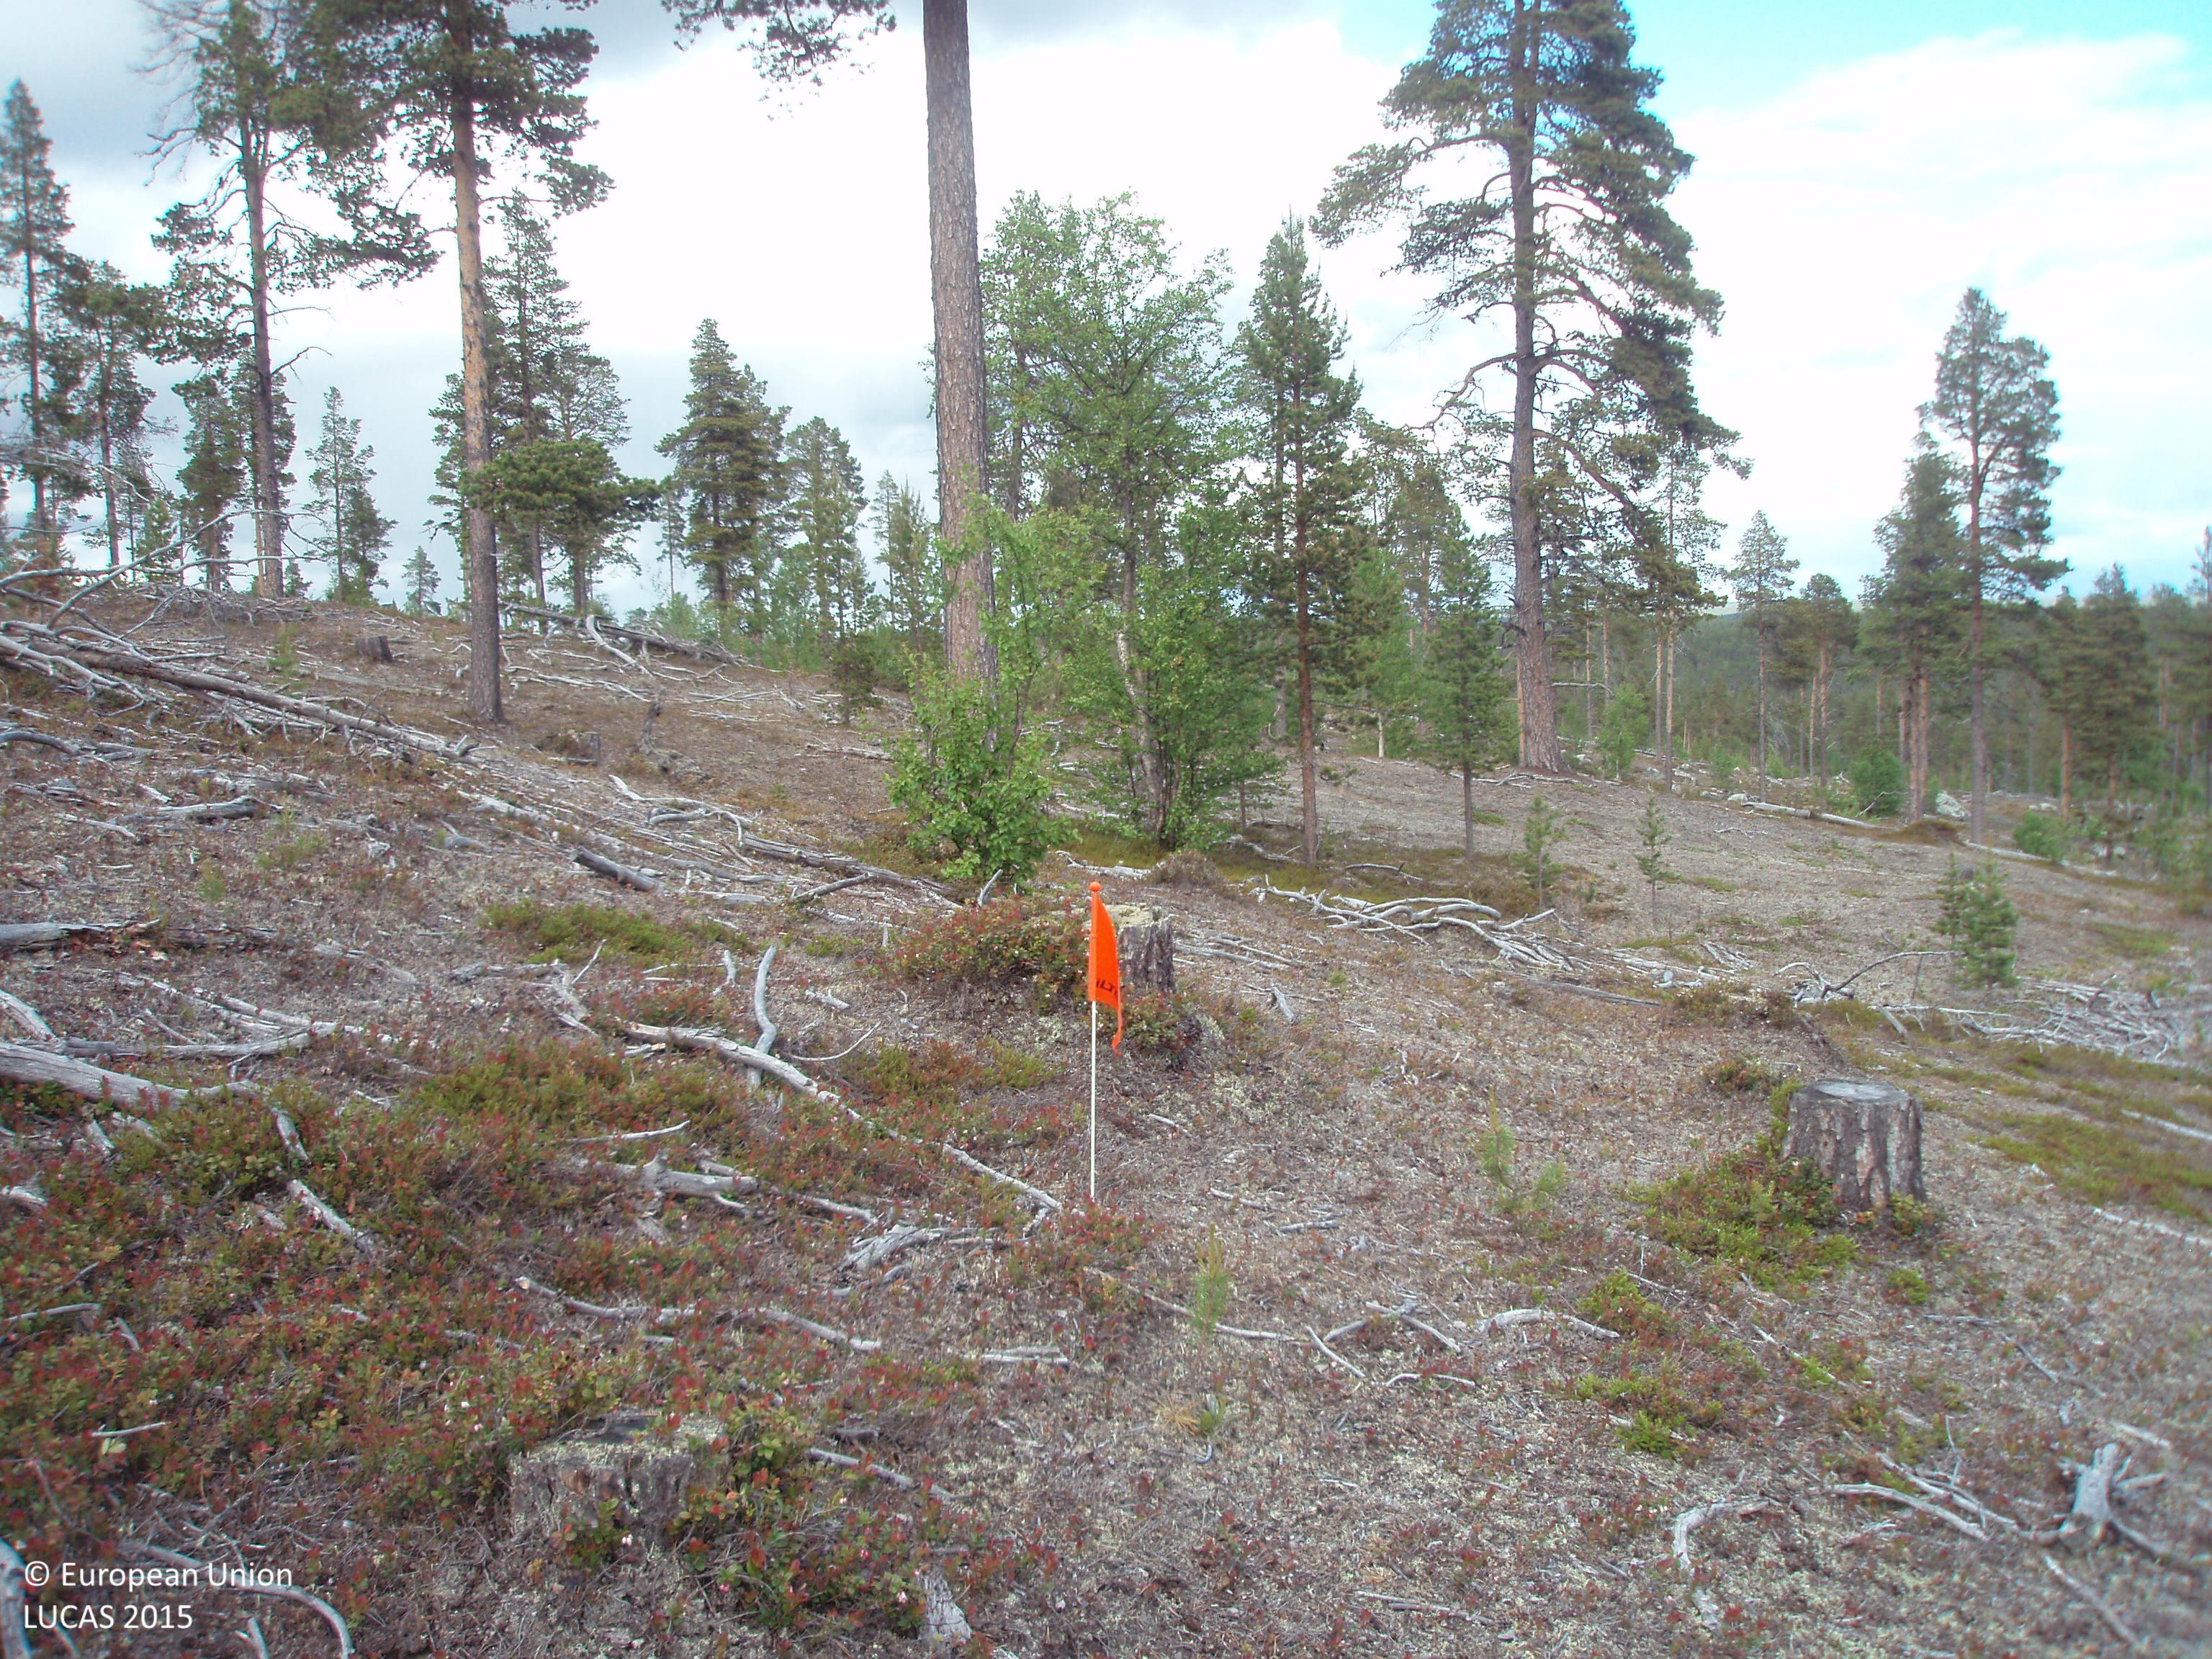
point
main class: Woodland
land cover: Pine dominated mixed woodland
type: boreal forest
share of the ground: 10 - 25 %
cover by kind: lichens and mosses 60 %, shrubs 25 %, coniferous forest trees 10 %, broadleaved forest trees 5 %
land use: Forestry
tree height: > 5 m
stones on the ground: < 10 %
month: July
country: FI
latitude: 69.2223
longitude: 27.8848
